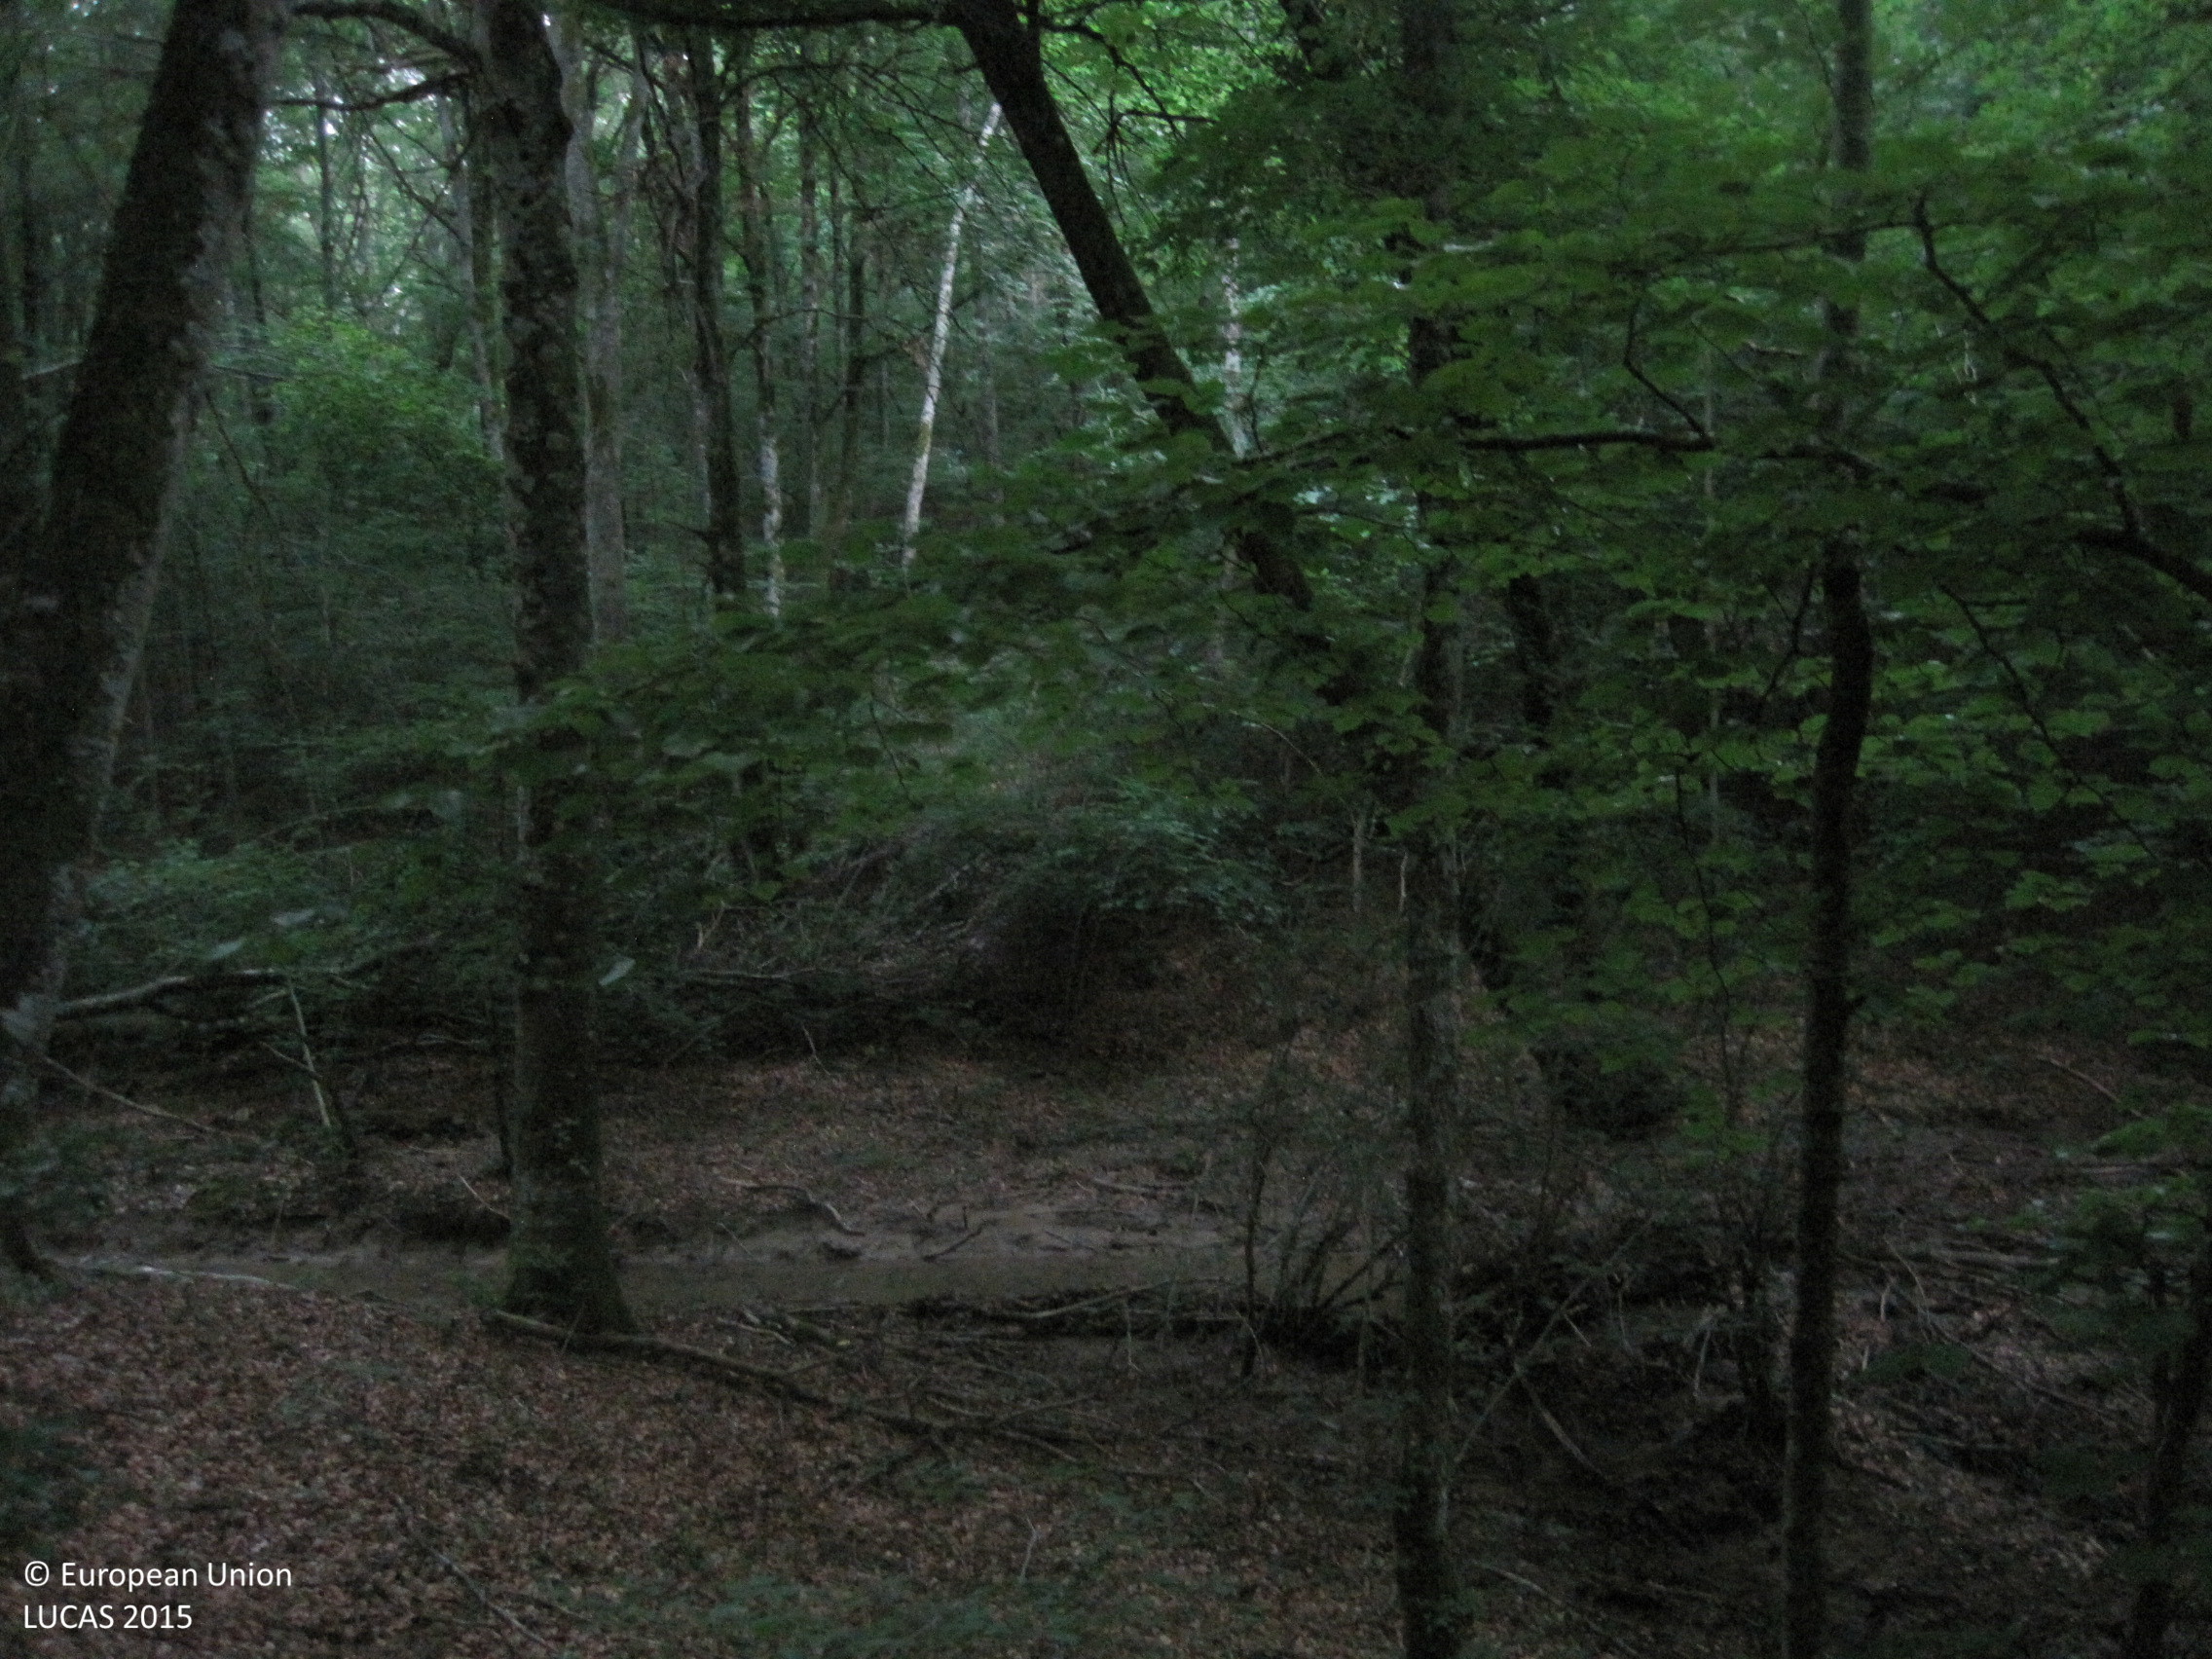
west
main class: Woodland
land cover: Broadleaved woodland
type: beech forest
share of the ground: > 75 %
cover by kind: broadleaved forest trees 100 %
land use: Forestry
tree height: > 5 m
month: June
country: ES
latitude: 42.9372
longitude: -1.7193
